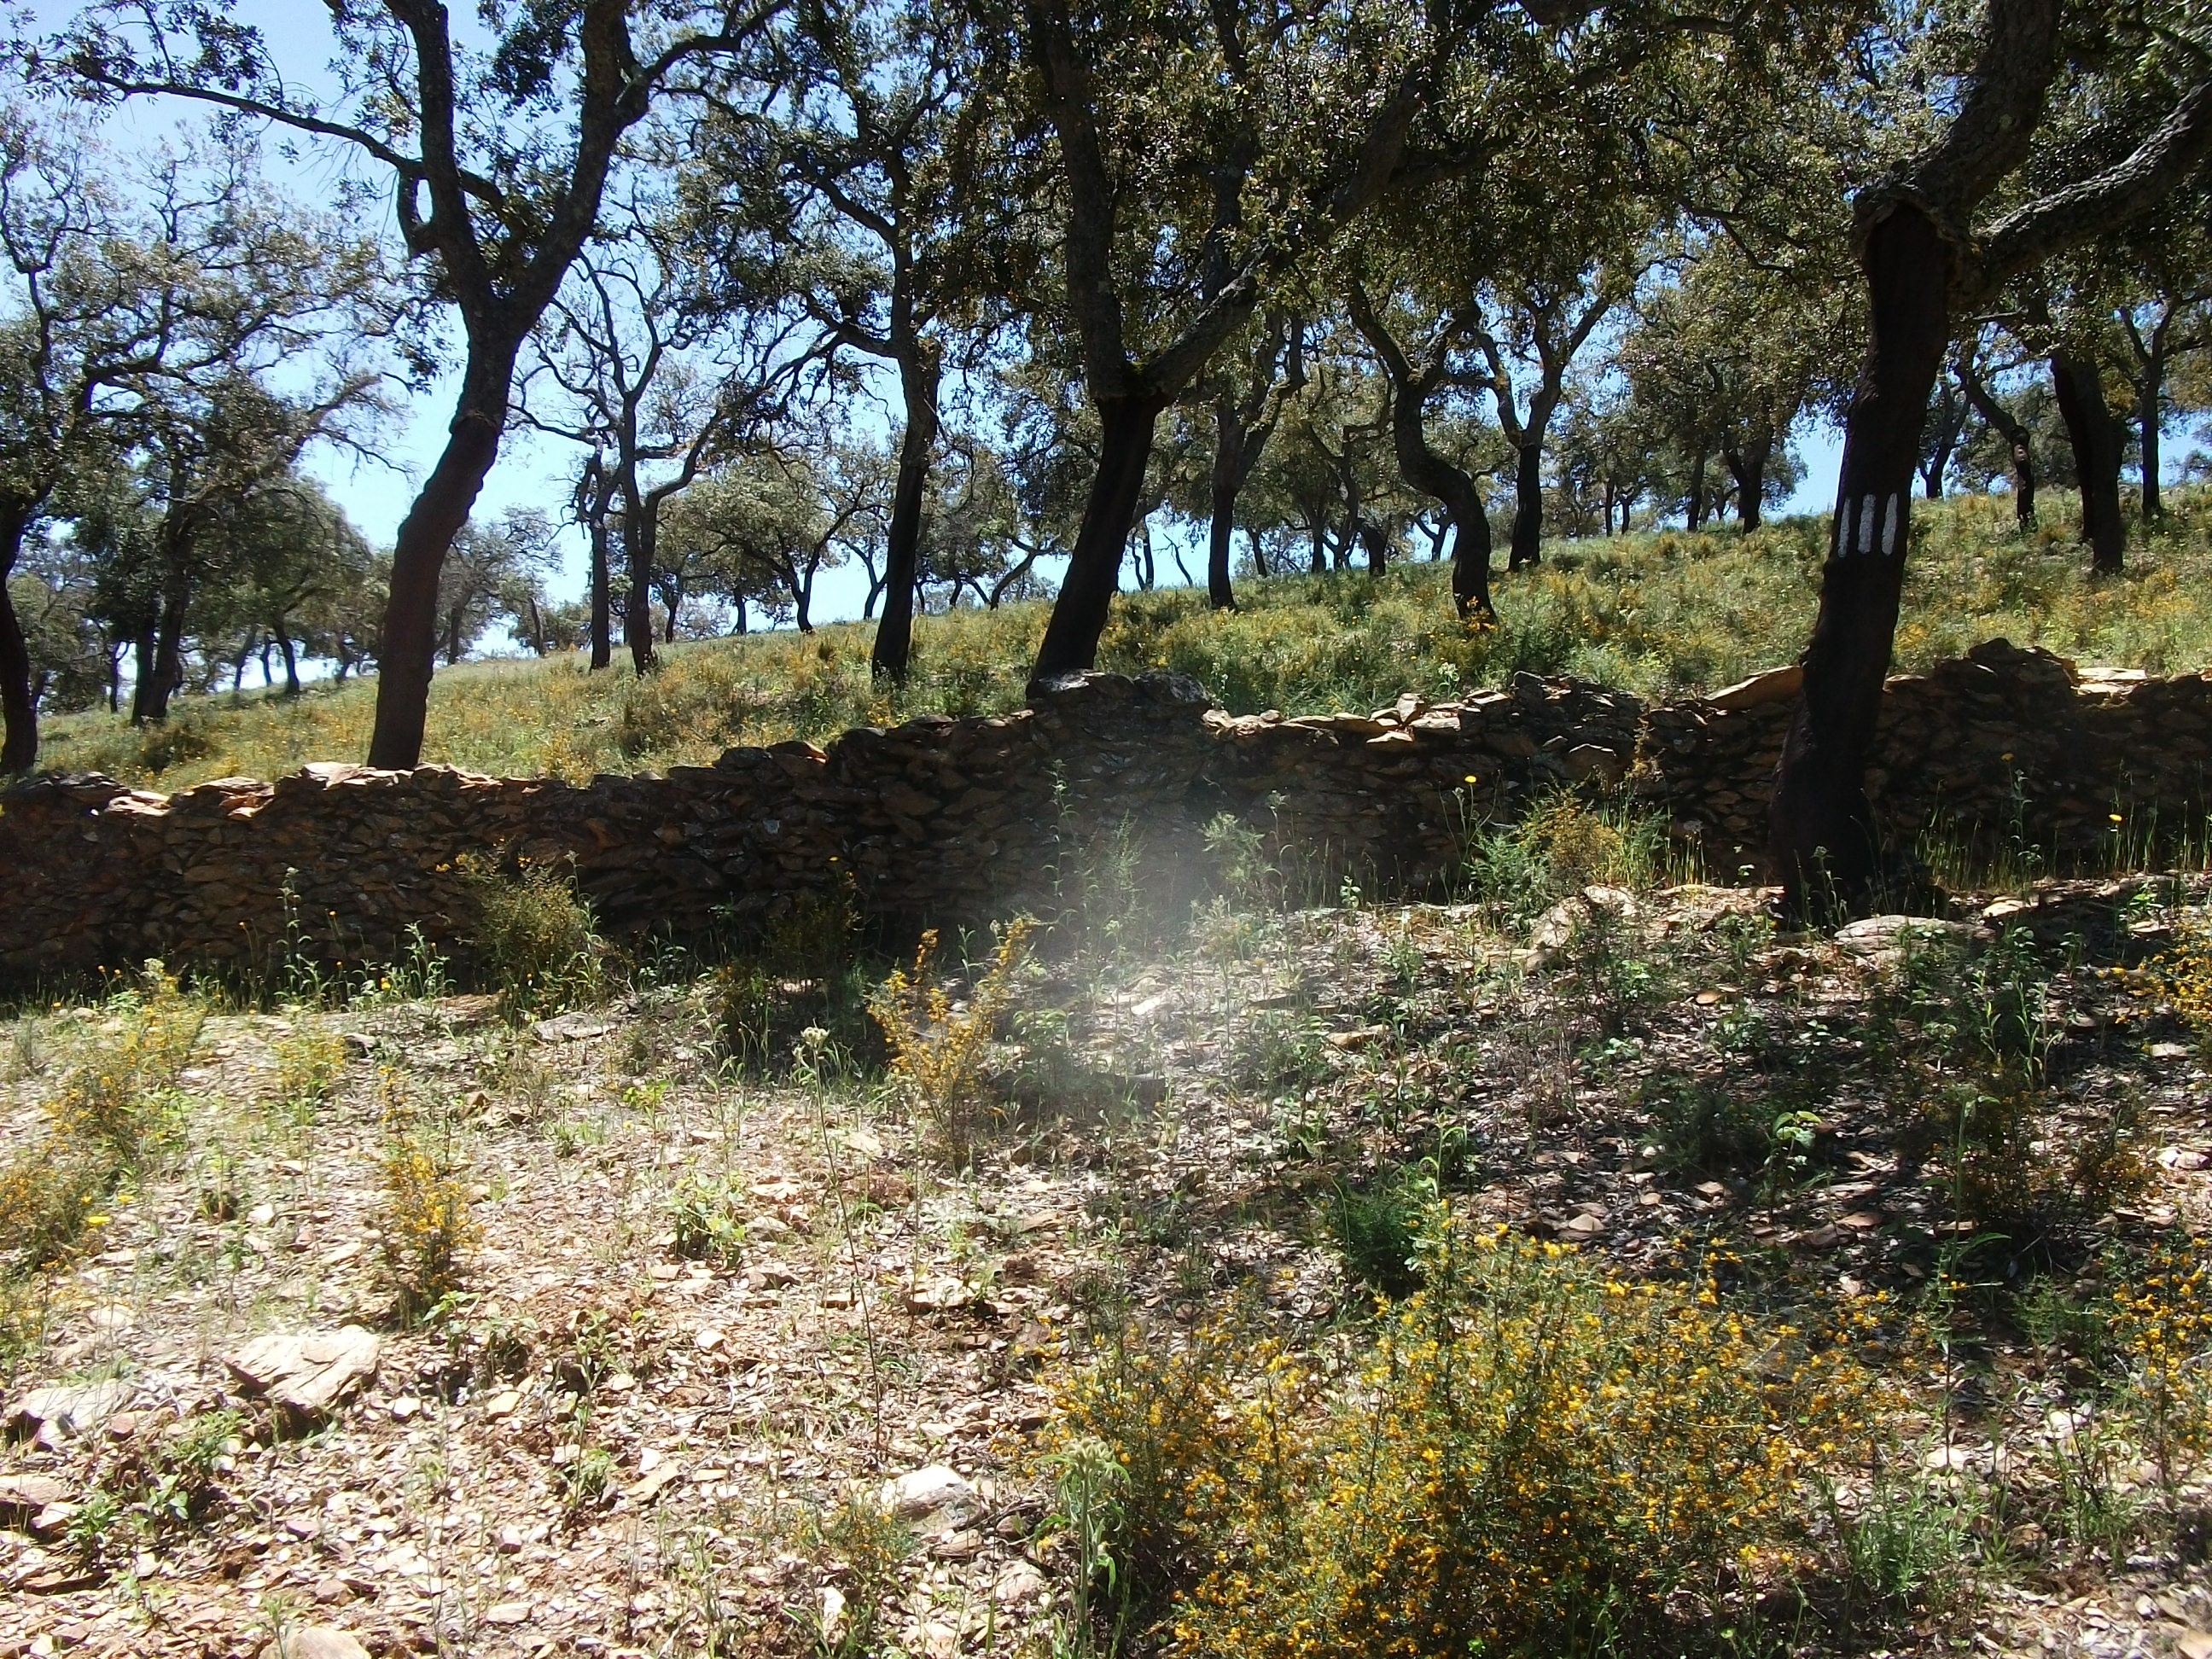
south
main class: Woodland
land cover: Broadleaved woodland
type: broadleaved evergreen forest
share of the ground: 50 - 75 %
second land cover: Spontaneously vegetated surfaces
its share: 10 - 25 %
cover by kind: broadleaved forest trees 70 %, herbaceous plants 20 %, shrubs 10 %
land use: Forestry
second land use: Agriculture (excluding fallow land and kitchen gardens)
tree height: > 5 m
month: April
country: ES
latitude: 37.7617
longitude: -6.5569
